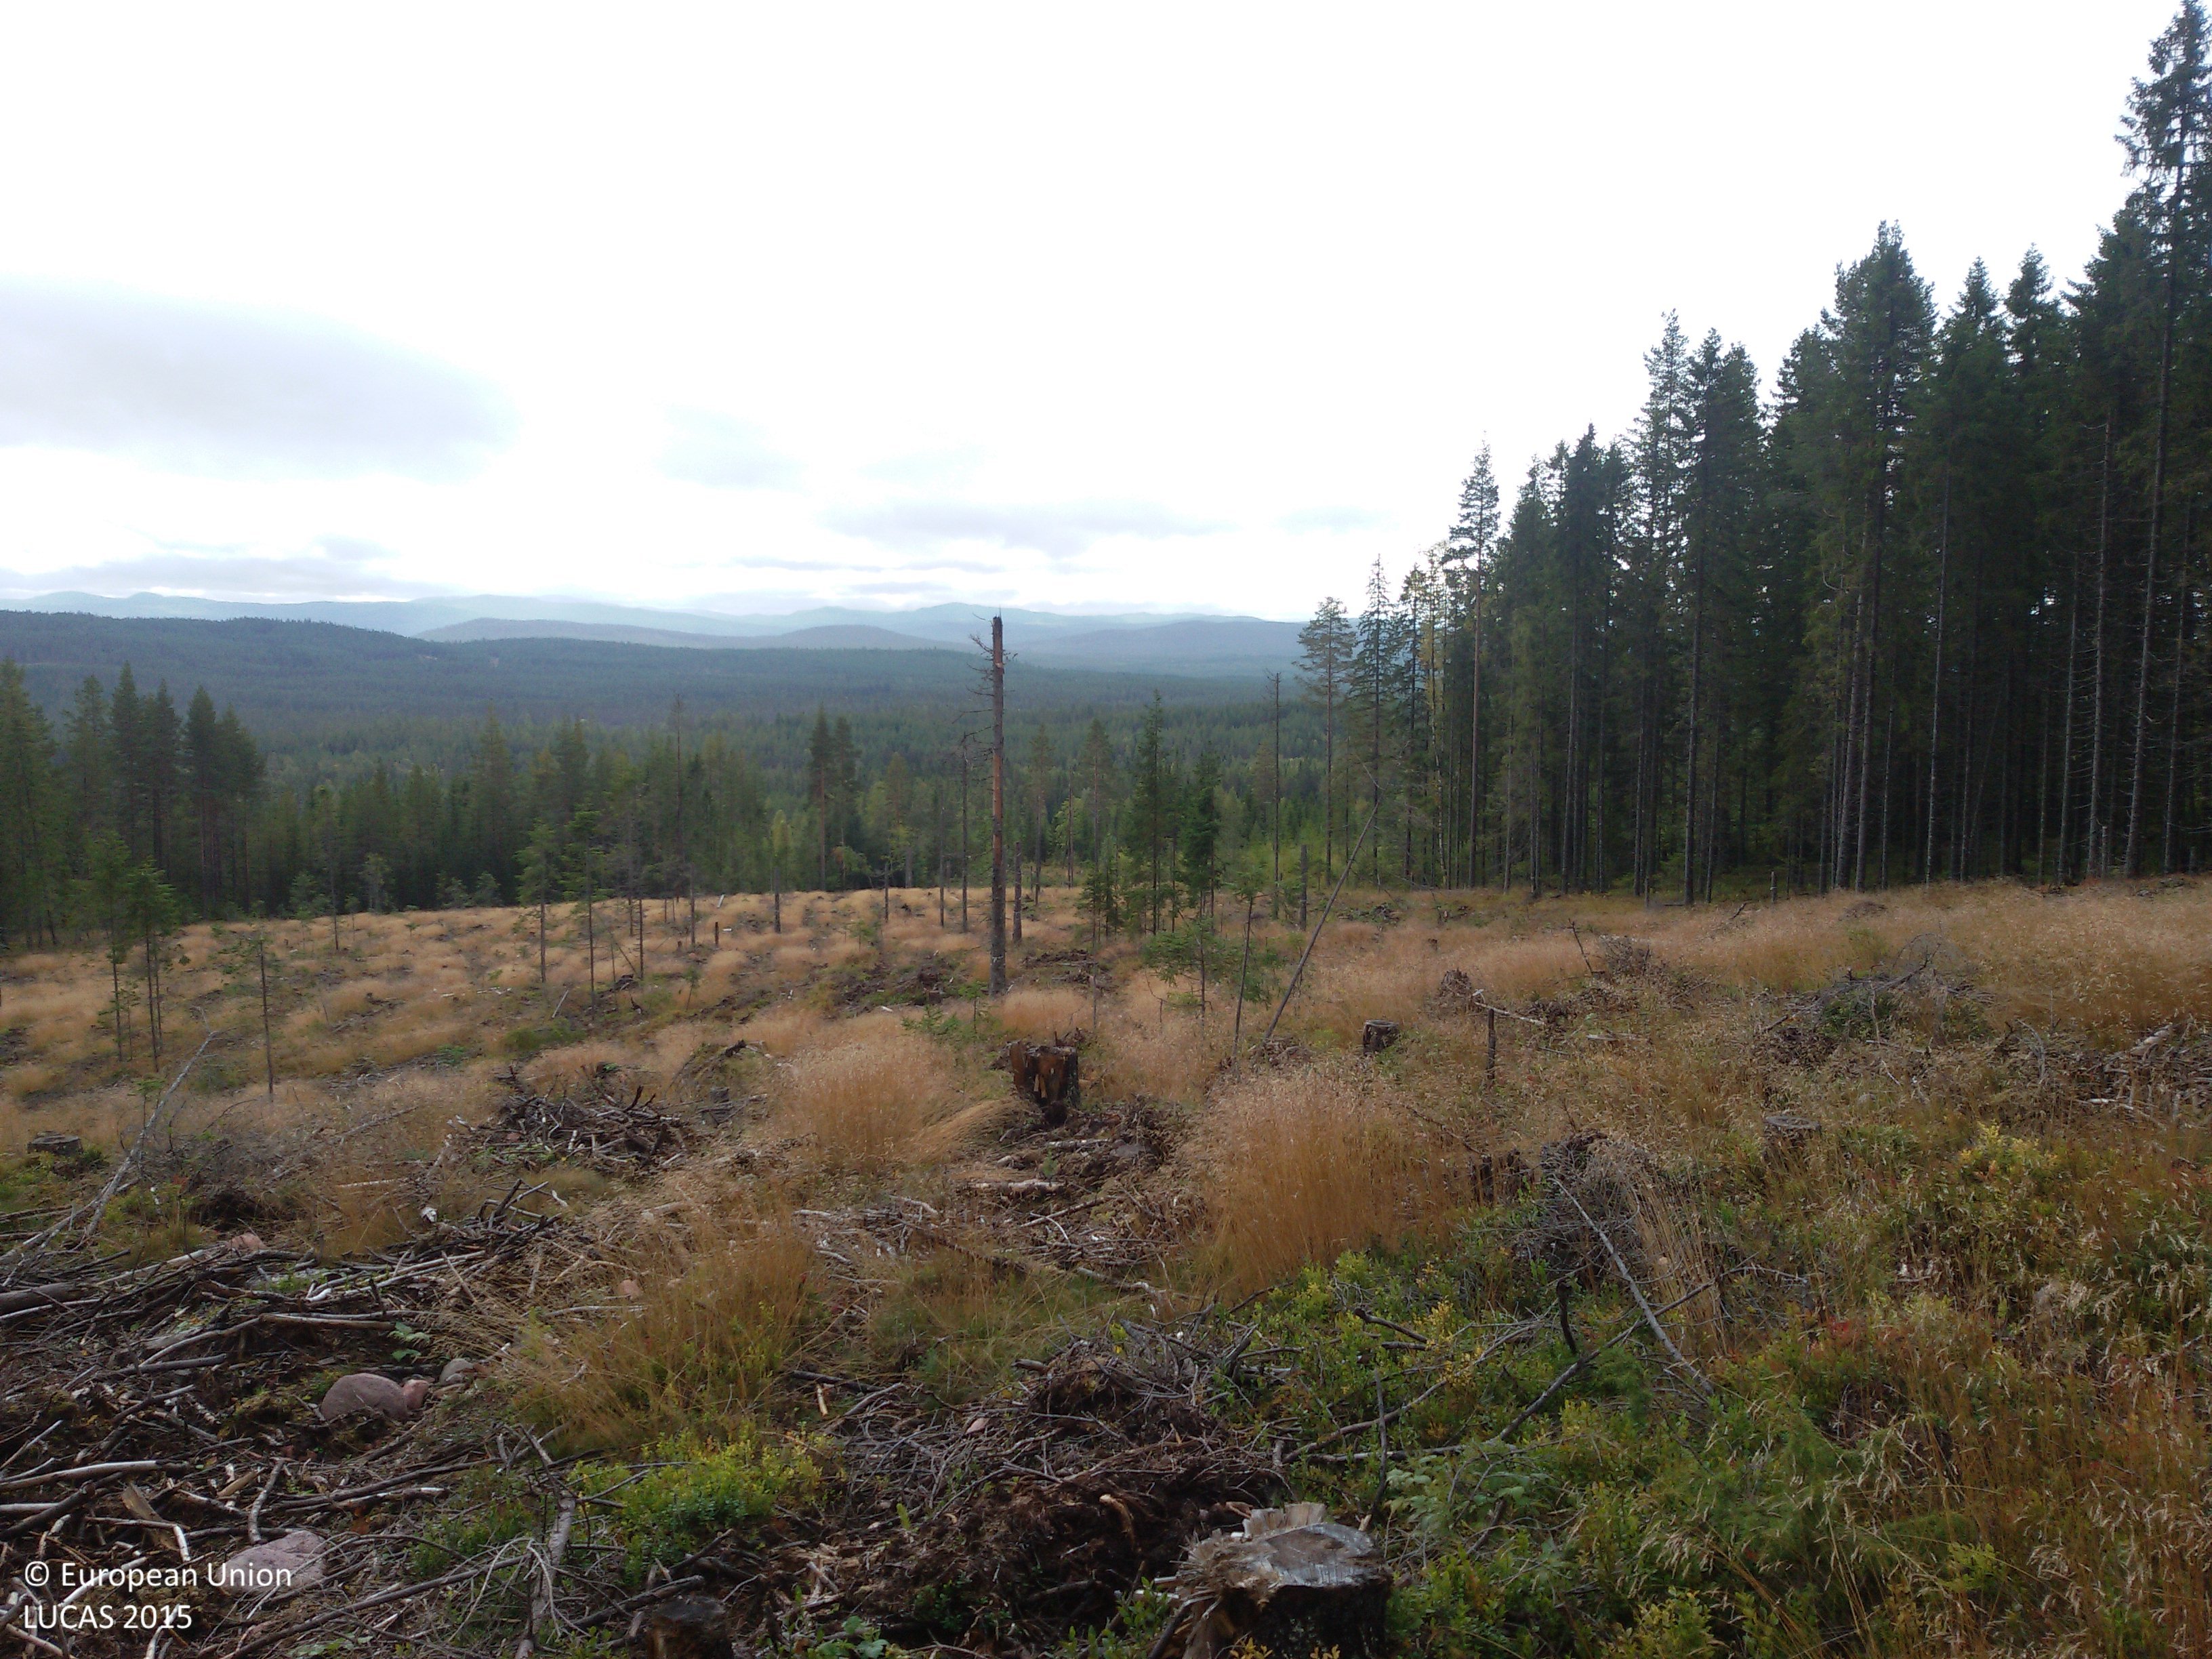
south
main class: Woodland
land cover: Spruce dominated coniferous woodland
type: boreal forest
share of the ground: < 10 %
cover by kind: herbaceous plants 70 %, unconsolidated bare surface 15 %, coniferous forest trees 10 %, lichens and mosses 5 %
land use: Forestry
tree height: < 5 m
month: September
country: SE
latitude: 60.9440
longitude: 14.3248
